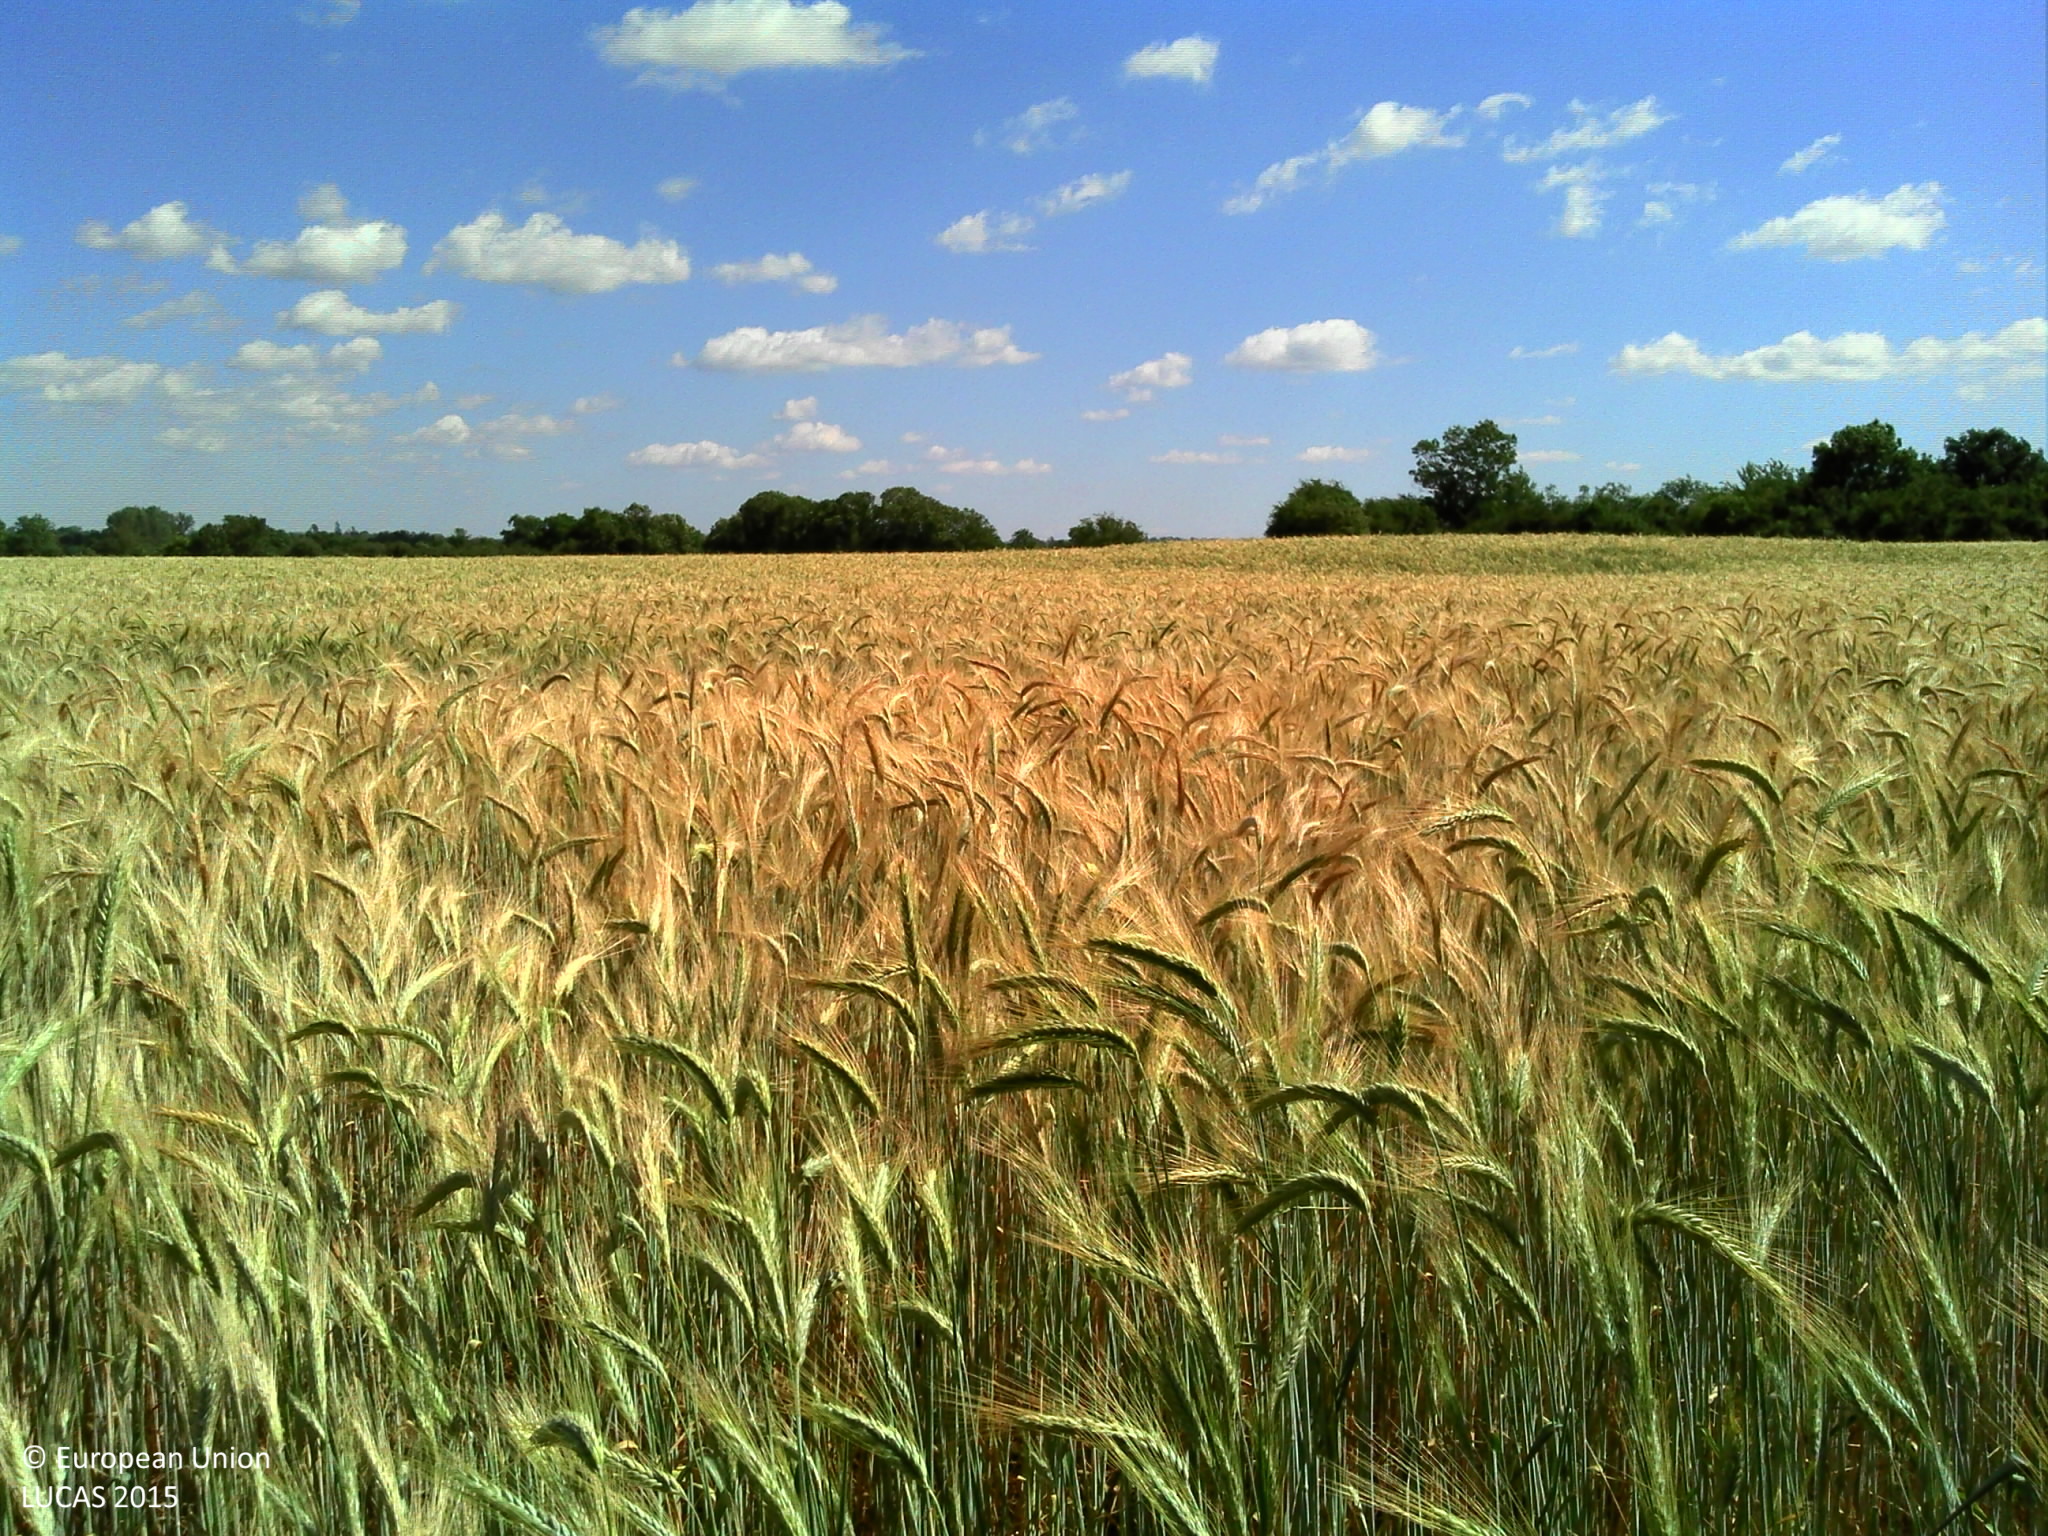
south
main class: Cropland
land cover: Triticale
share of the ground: > 75 %
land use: Agriculture (excluding fallow land and kitchen gardens)
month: June
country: FR
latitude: 44.4035
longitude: 2.4816
